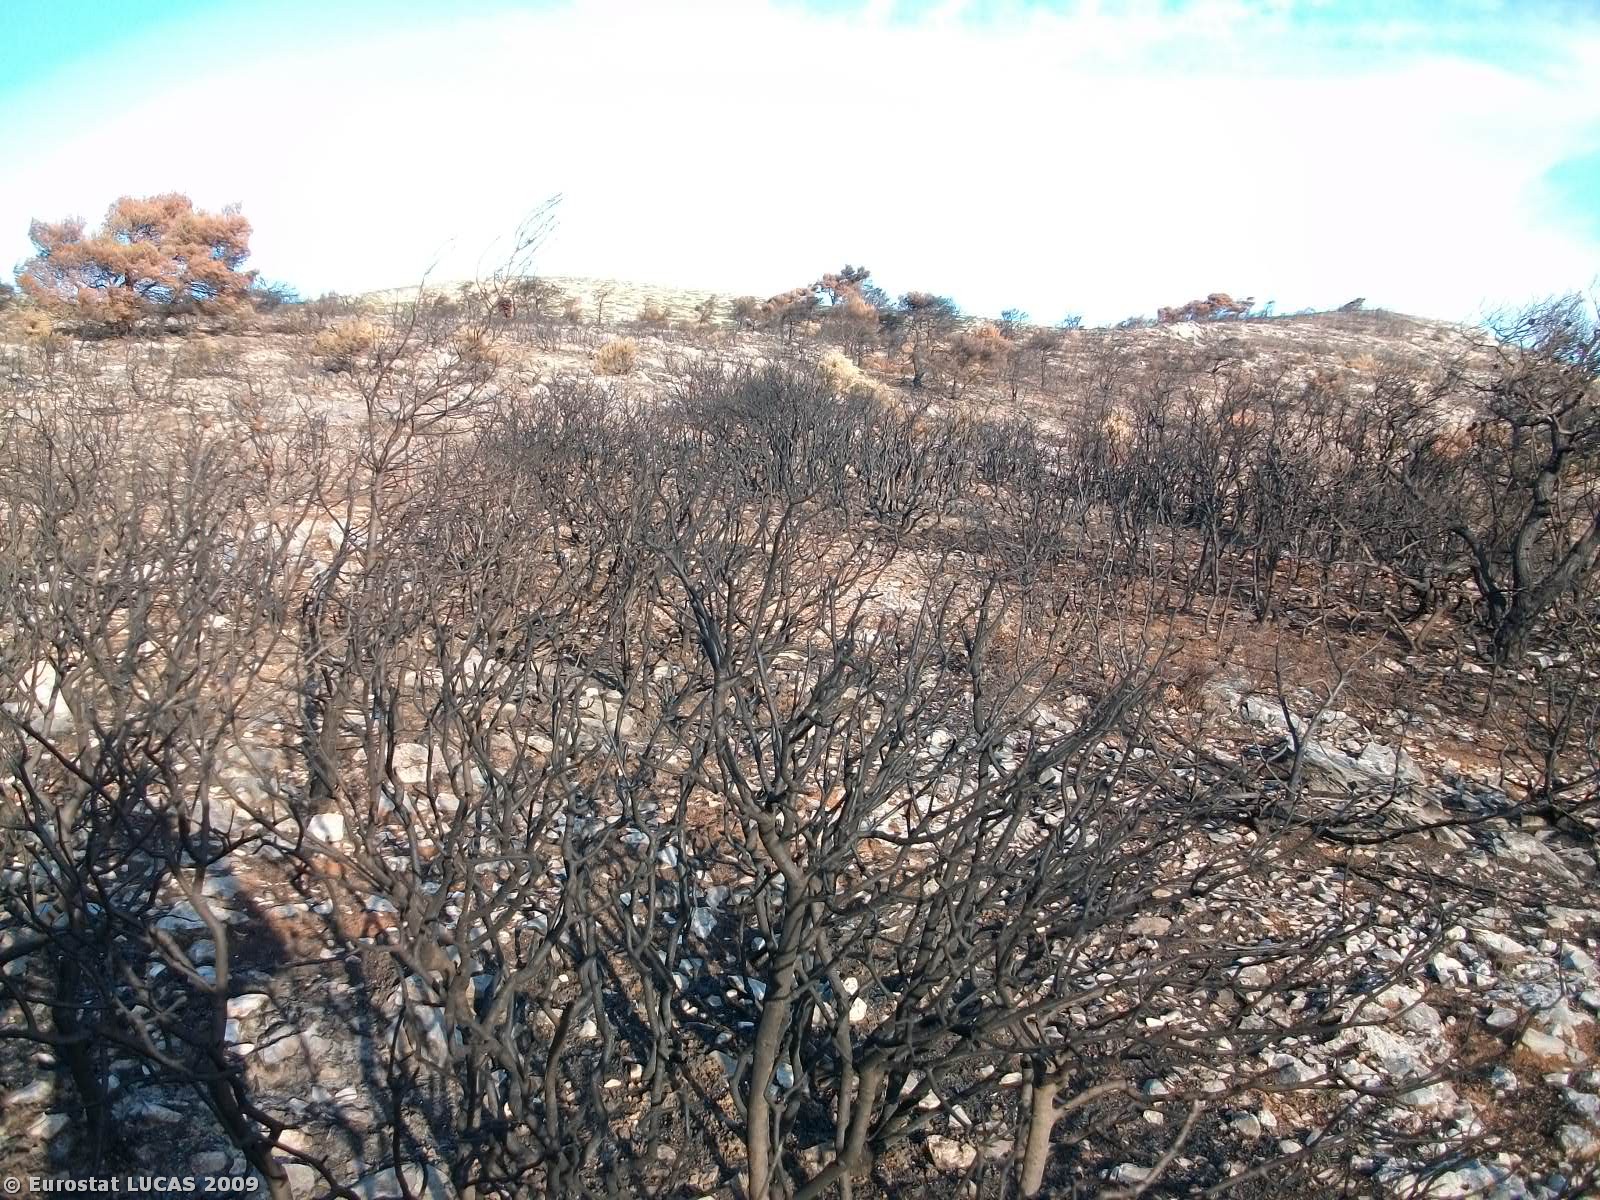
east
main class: Woodland
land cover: Mixed woodland
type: non-riverine alder, birch or aspen forest
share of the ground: < 10 %
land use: Forestry
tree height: > 5 m
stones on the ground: 25 - 50 %
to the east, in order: Mixed woodland
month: September
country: GR
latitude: 38.1945
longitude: 23.9968
